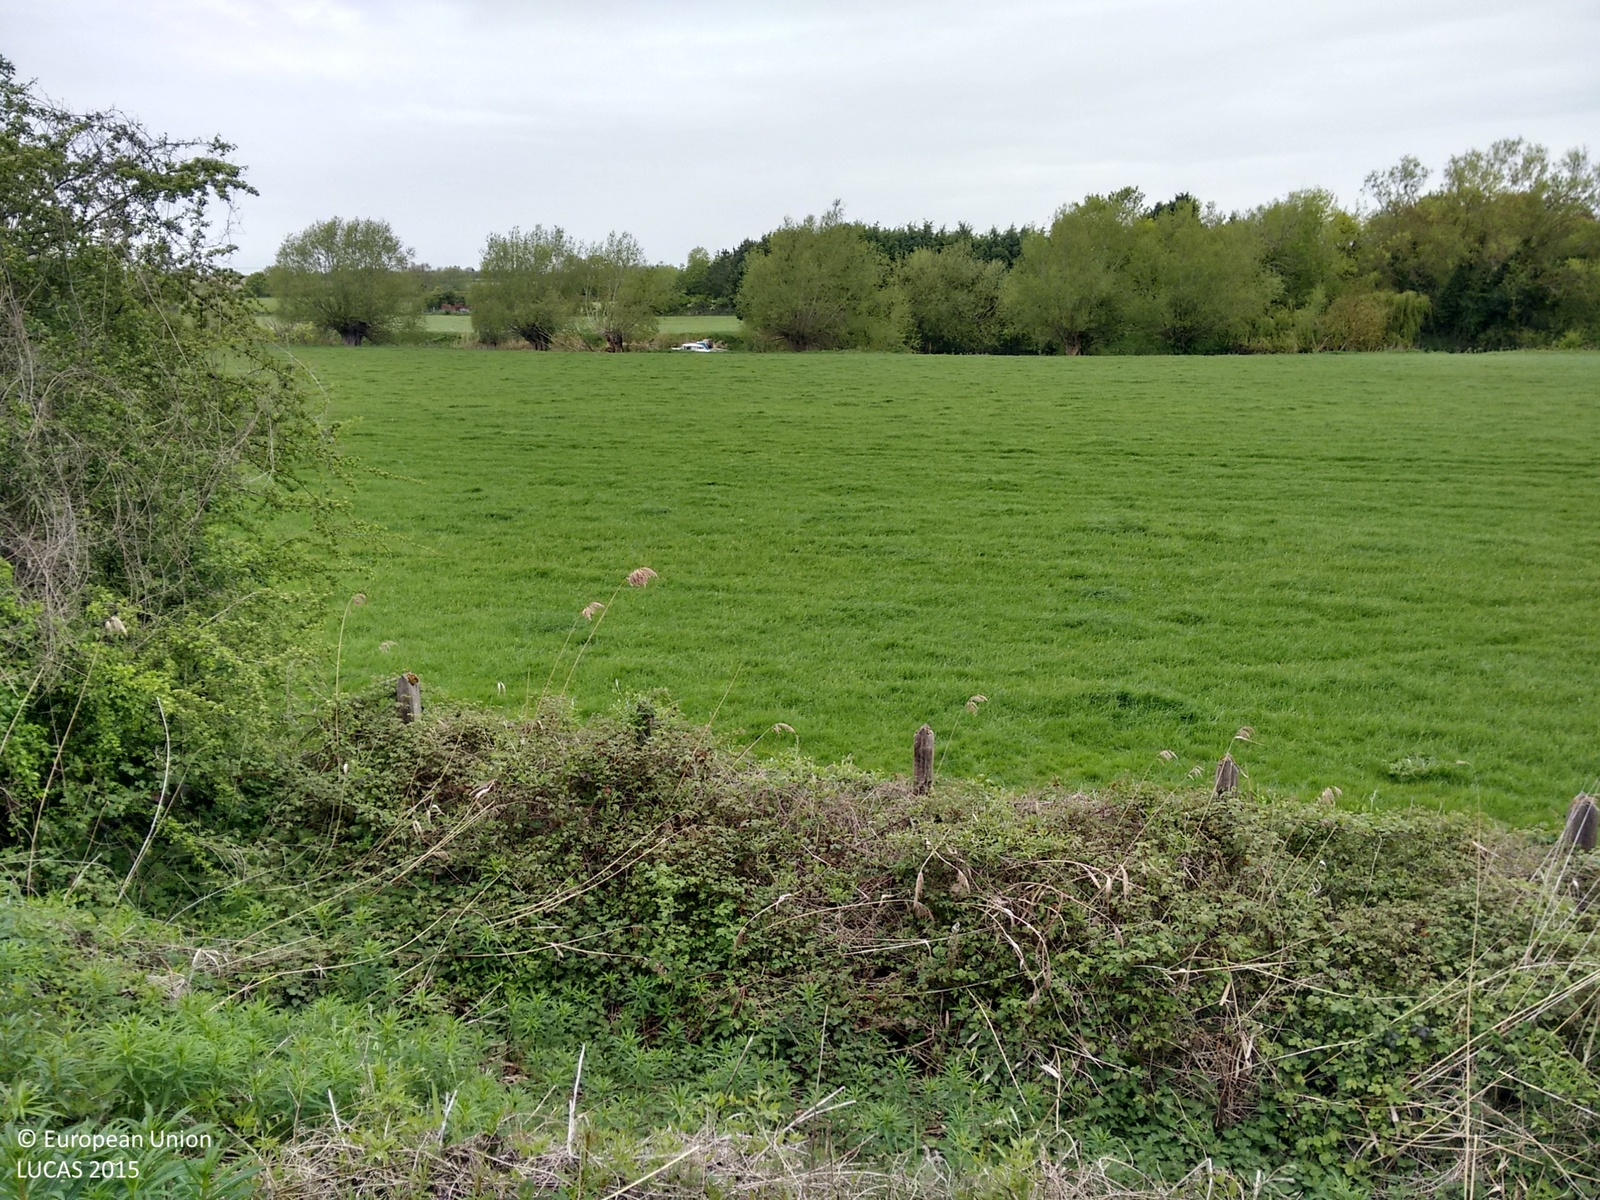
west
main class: Grassland
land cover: Grassland without tree/shrub cover
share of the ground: > 75 %
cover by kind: herbaceous plants 100 %
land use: Agriculture (excluding fallow land and kitchen gardens)
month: May
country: GB
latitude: 52.1744
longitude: -1.7381
